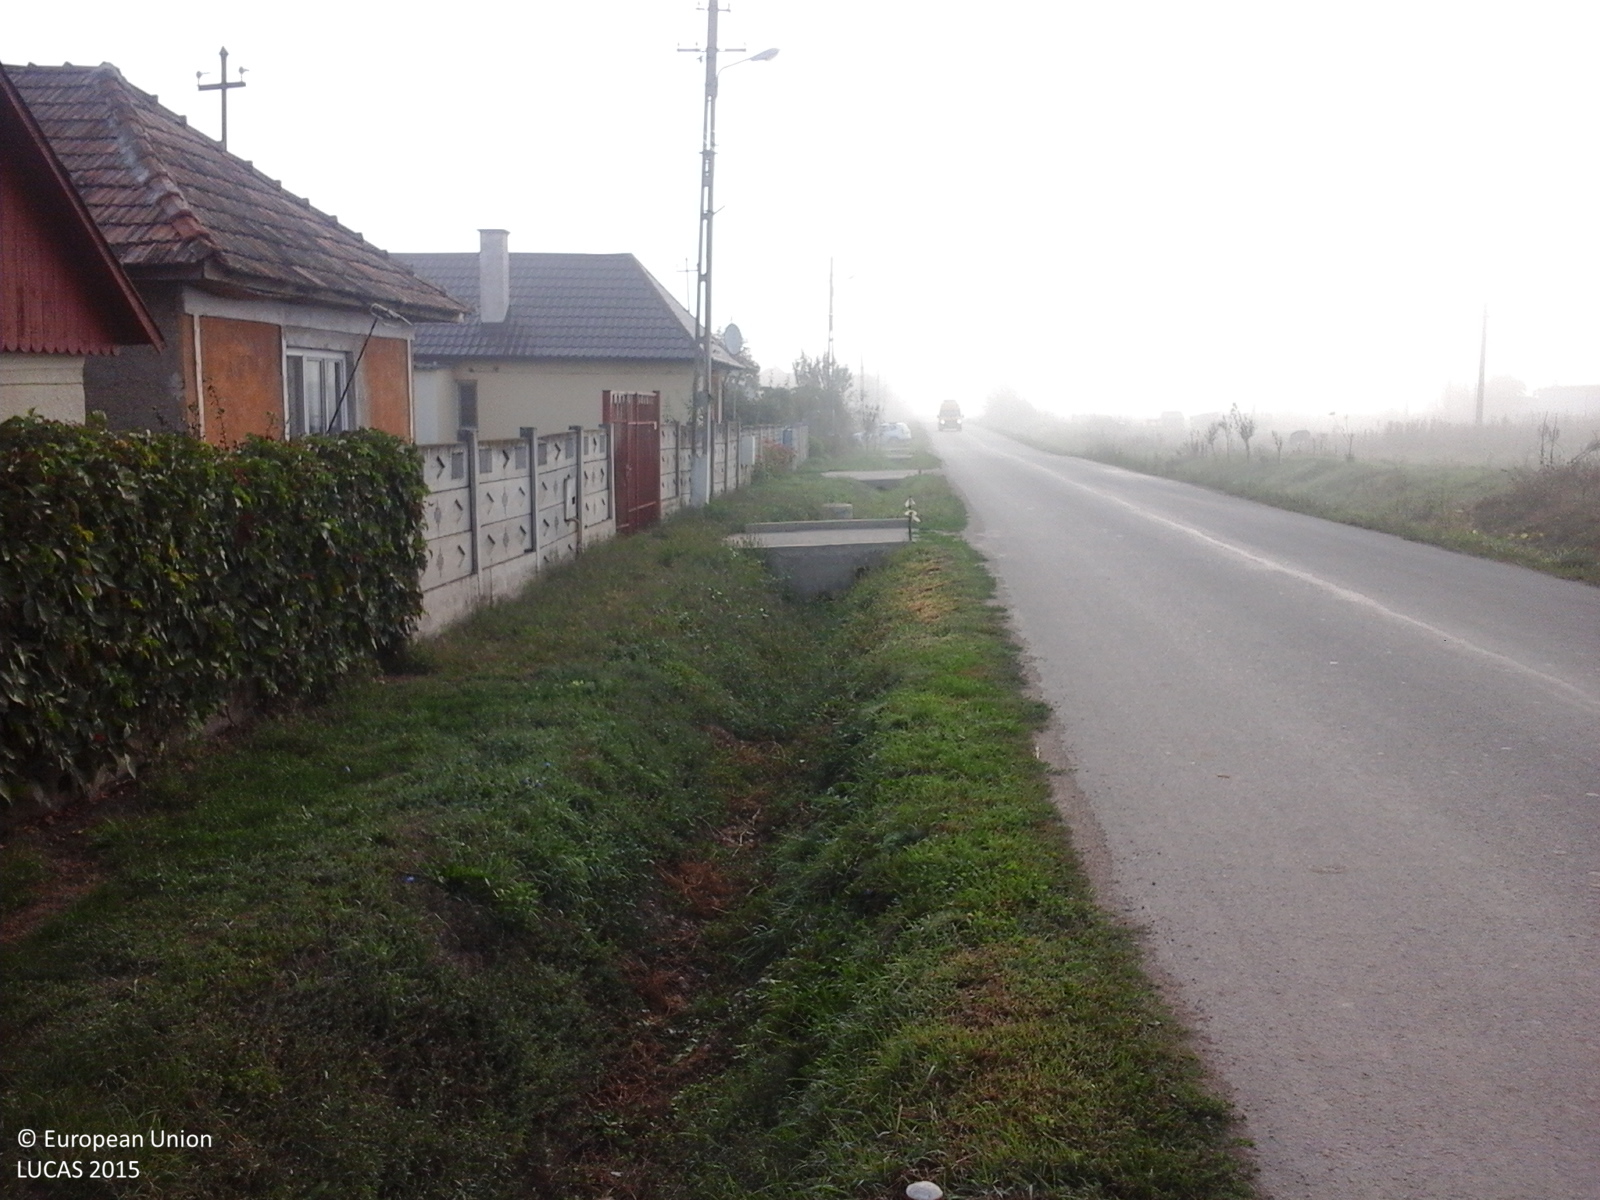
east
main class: Grassland
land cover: Grassland without tree/shrub cover
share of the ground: > 75 %
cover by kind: herbaceous plants 100 %
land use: Agriculture (excluding fallow land and kitchen gardens)
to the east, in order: Grassland without tree/shrub cover; Artificial constructions in urban areas; Other fresh vegetables; Artificial constructions in urban areas; Grassland without tree/shrub cover; Artificial constructions in urban areas; Grassland without tree/shrub cover; Electric lines; Grassland without tree/shrub cover; Tracks; Spontaneously vegetated surfaces; Electric lines; Spontaneously vegetated surfaces
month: September
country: RO
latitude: 46.8598
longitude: 23.7823
